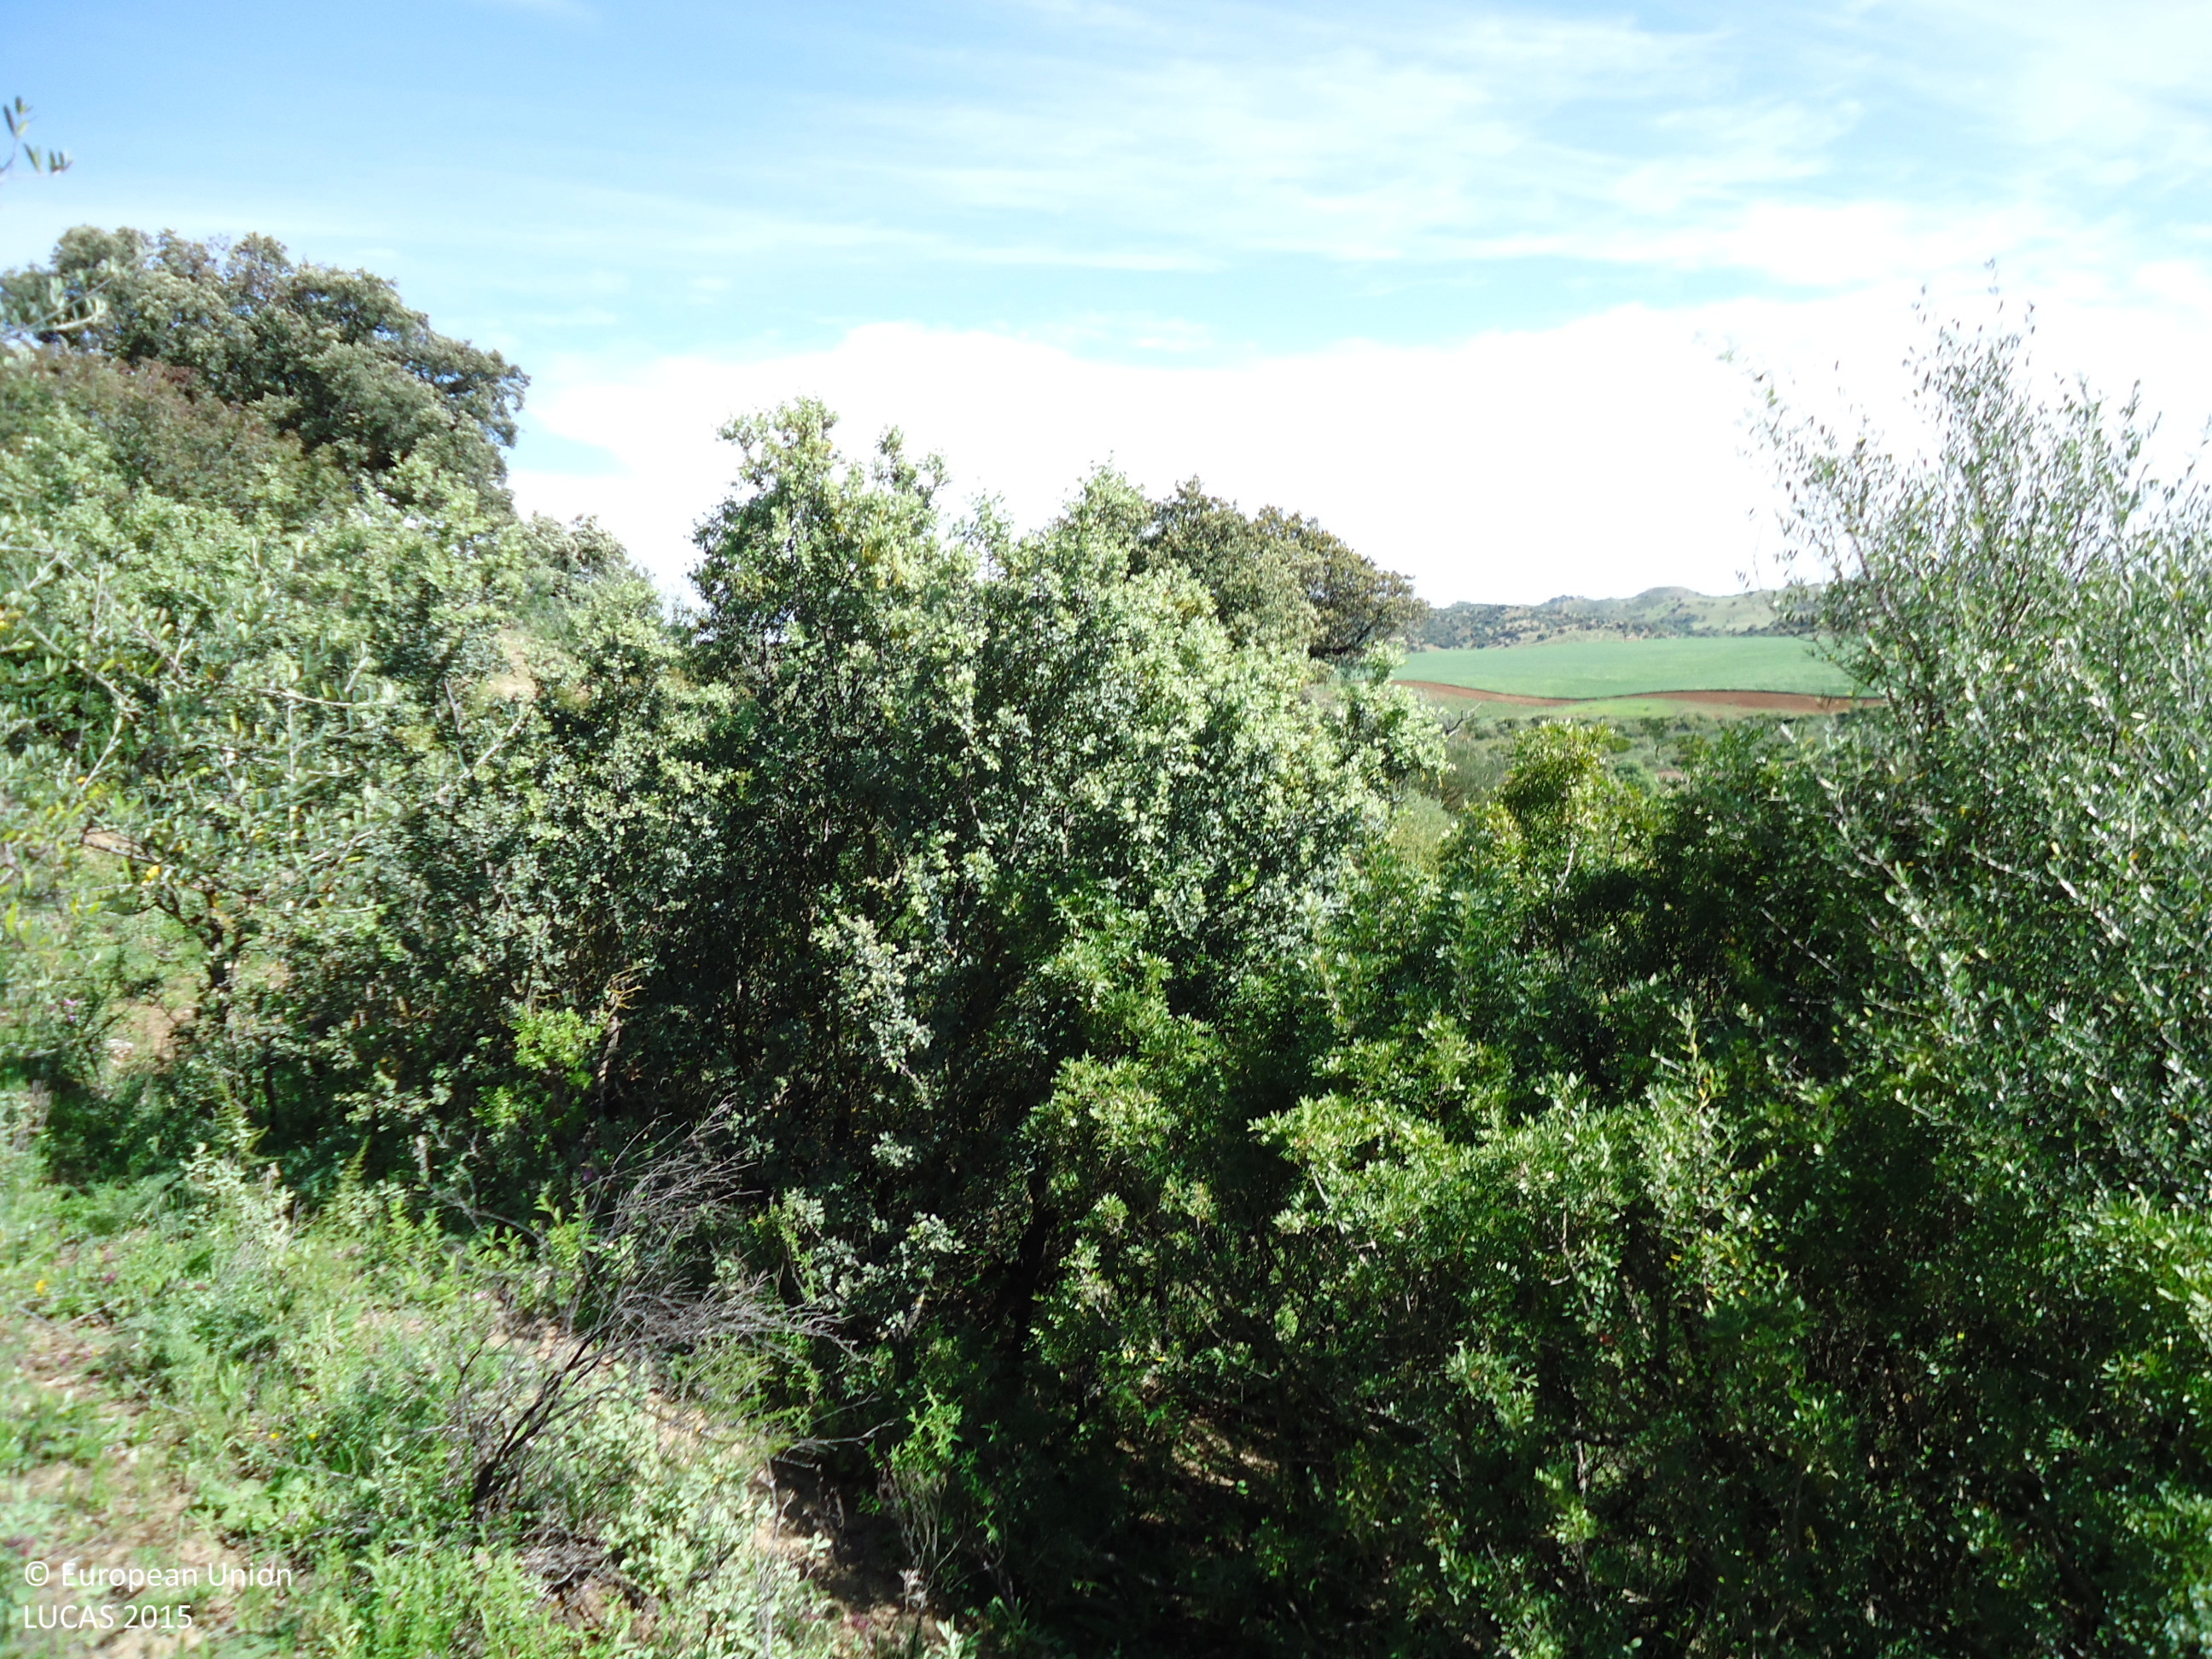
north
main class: Shrubland
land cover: Shrubland with sparse tree cover
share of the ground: 50 - 75 %
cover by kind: shrubs 70 %, herbaceous plants 25 %, broadleaved forest trees 5 %
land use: Agriculture (excluding fallow land and kitchen gardens)
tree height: > 5 m
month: April
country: ES
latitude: 36.9348
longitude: -5.3533
